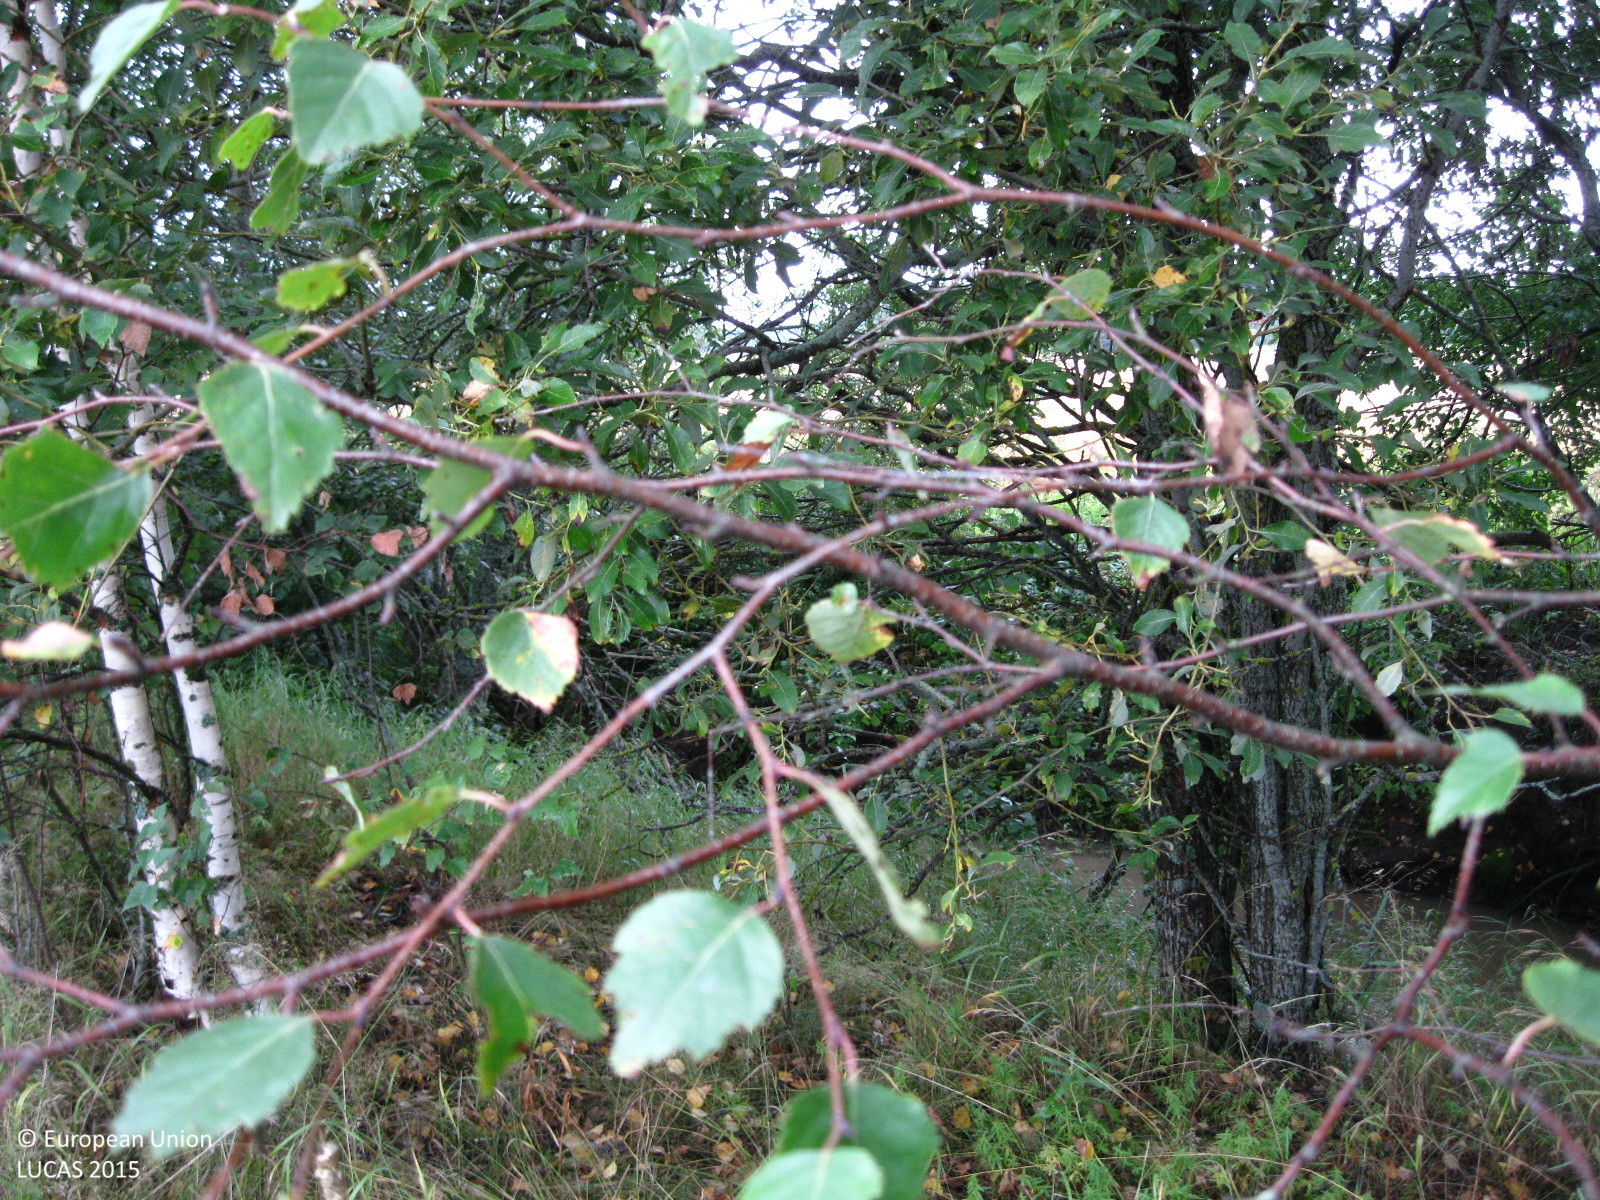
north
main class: Cropland
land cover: Oats
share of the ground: > 75 %
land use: Agriculture (excluding fallow land and kitchen gardens)
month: September
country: FI
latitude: 60.4540
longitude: 24.6724
